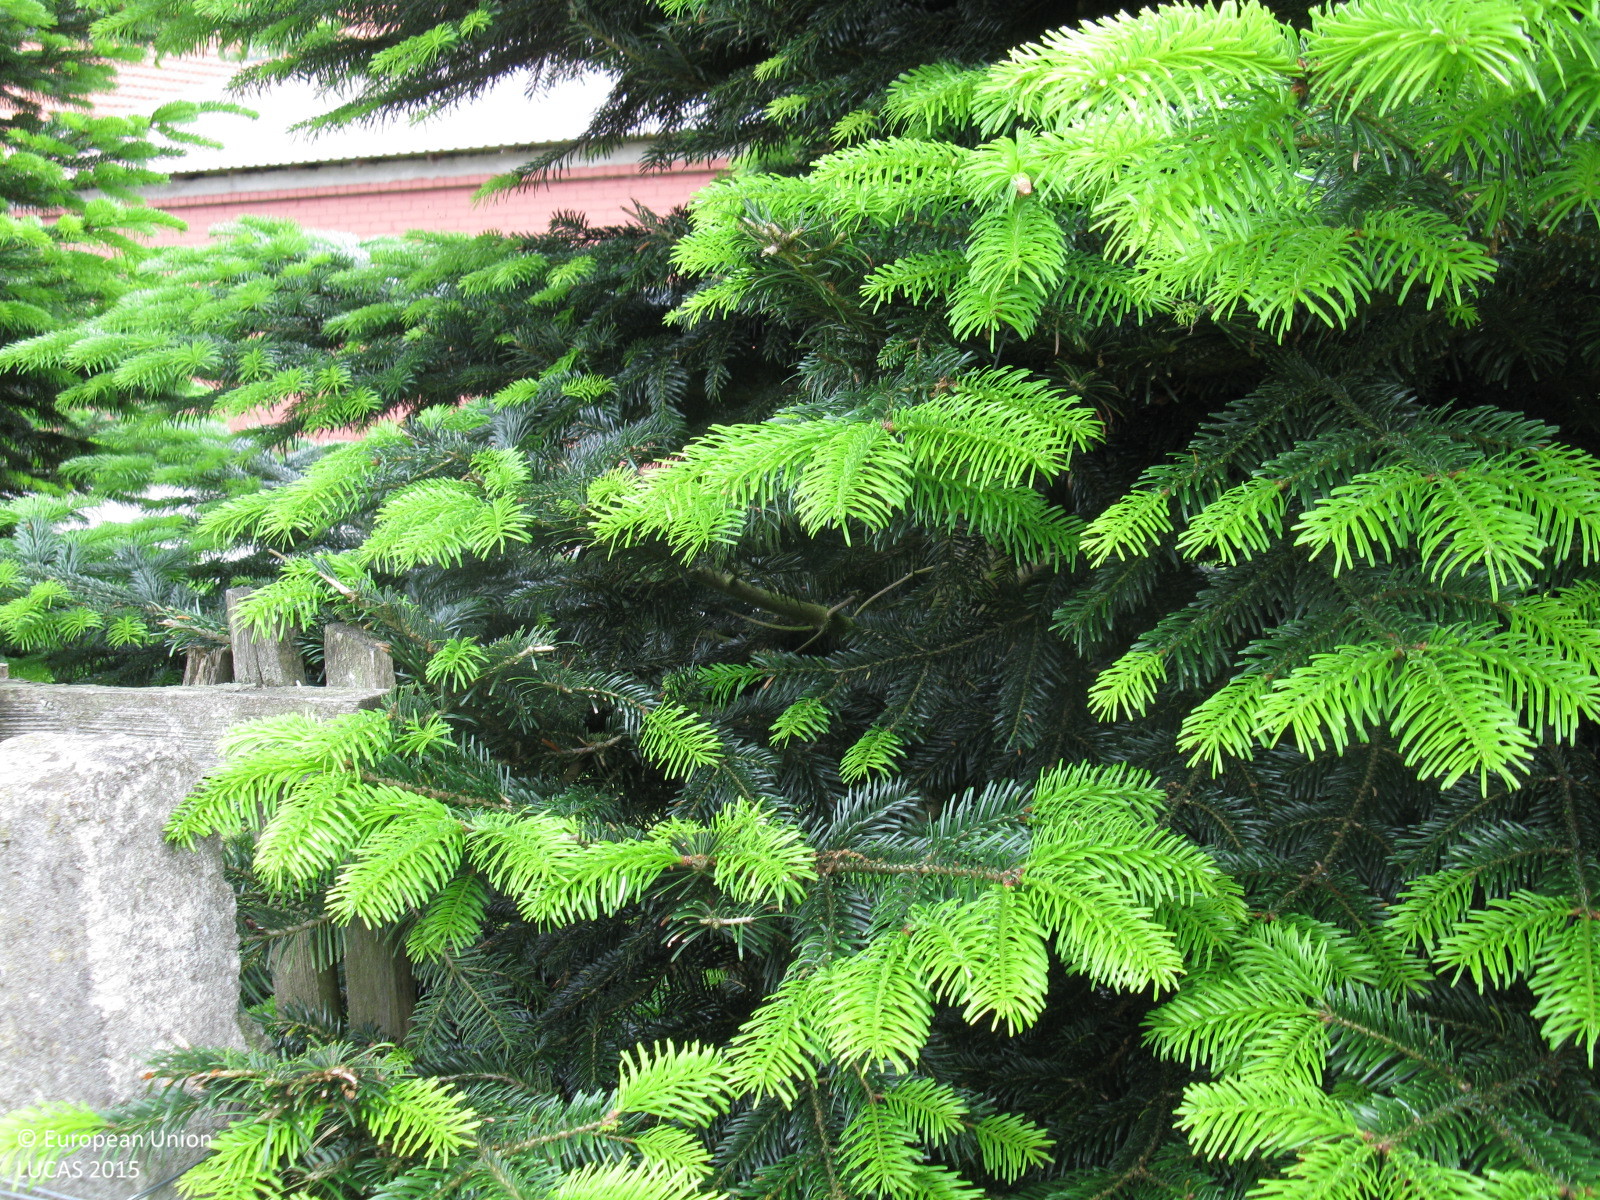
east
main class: Grassland
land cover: Grassland without tree/shrub cover
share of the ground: > 75 %
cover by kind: herbaceous plants 100 %
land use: Agriculture (excluding fallow land and kitchen gardens)
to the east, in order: Grassland without tree/shrub cover; Fences; Broadleaved woodland; Inland fresh running water; Common wheat; Maize; Broadleaved woodland; Maize; Broadleaved woodland
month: June
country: DE
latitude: 53.5091
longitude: 7.8746
